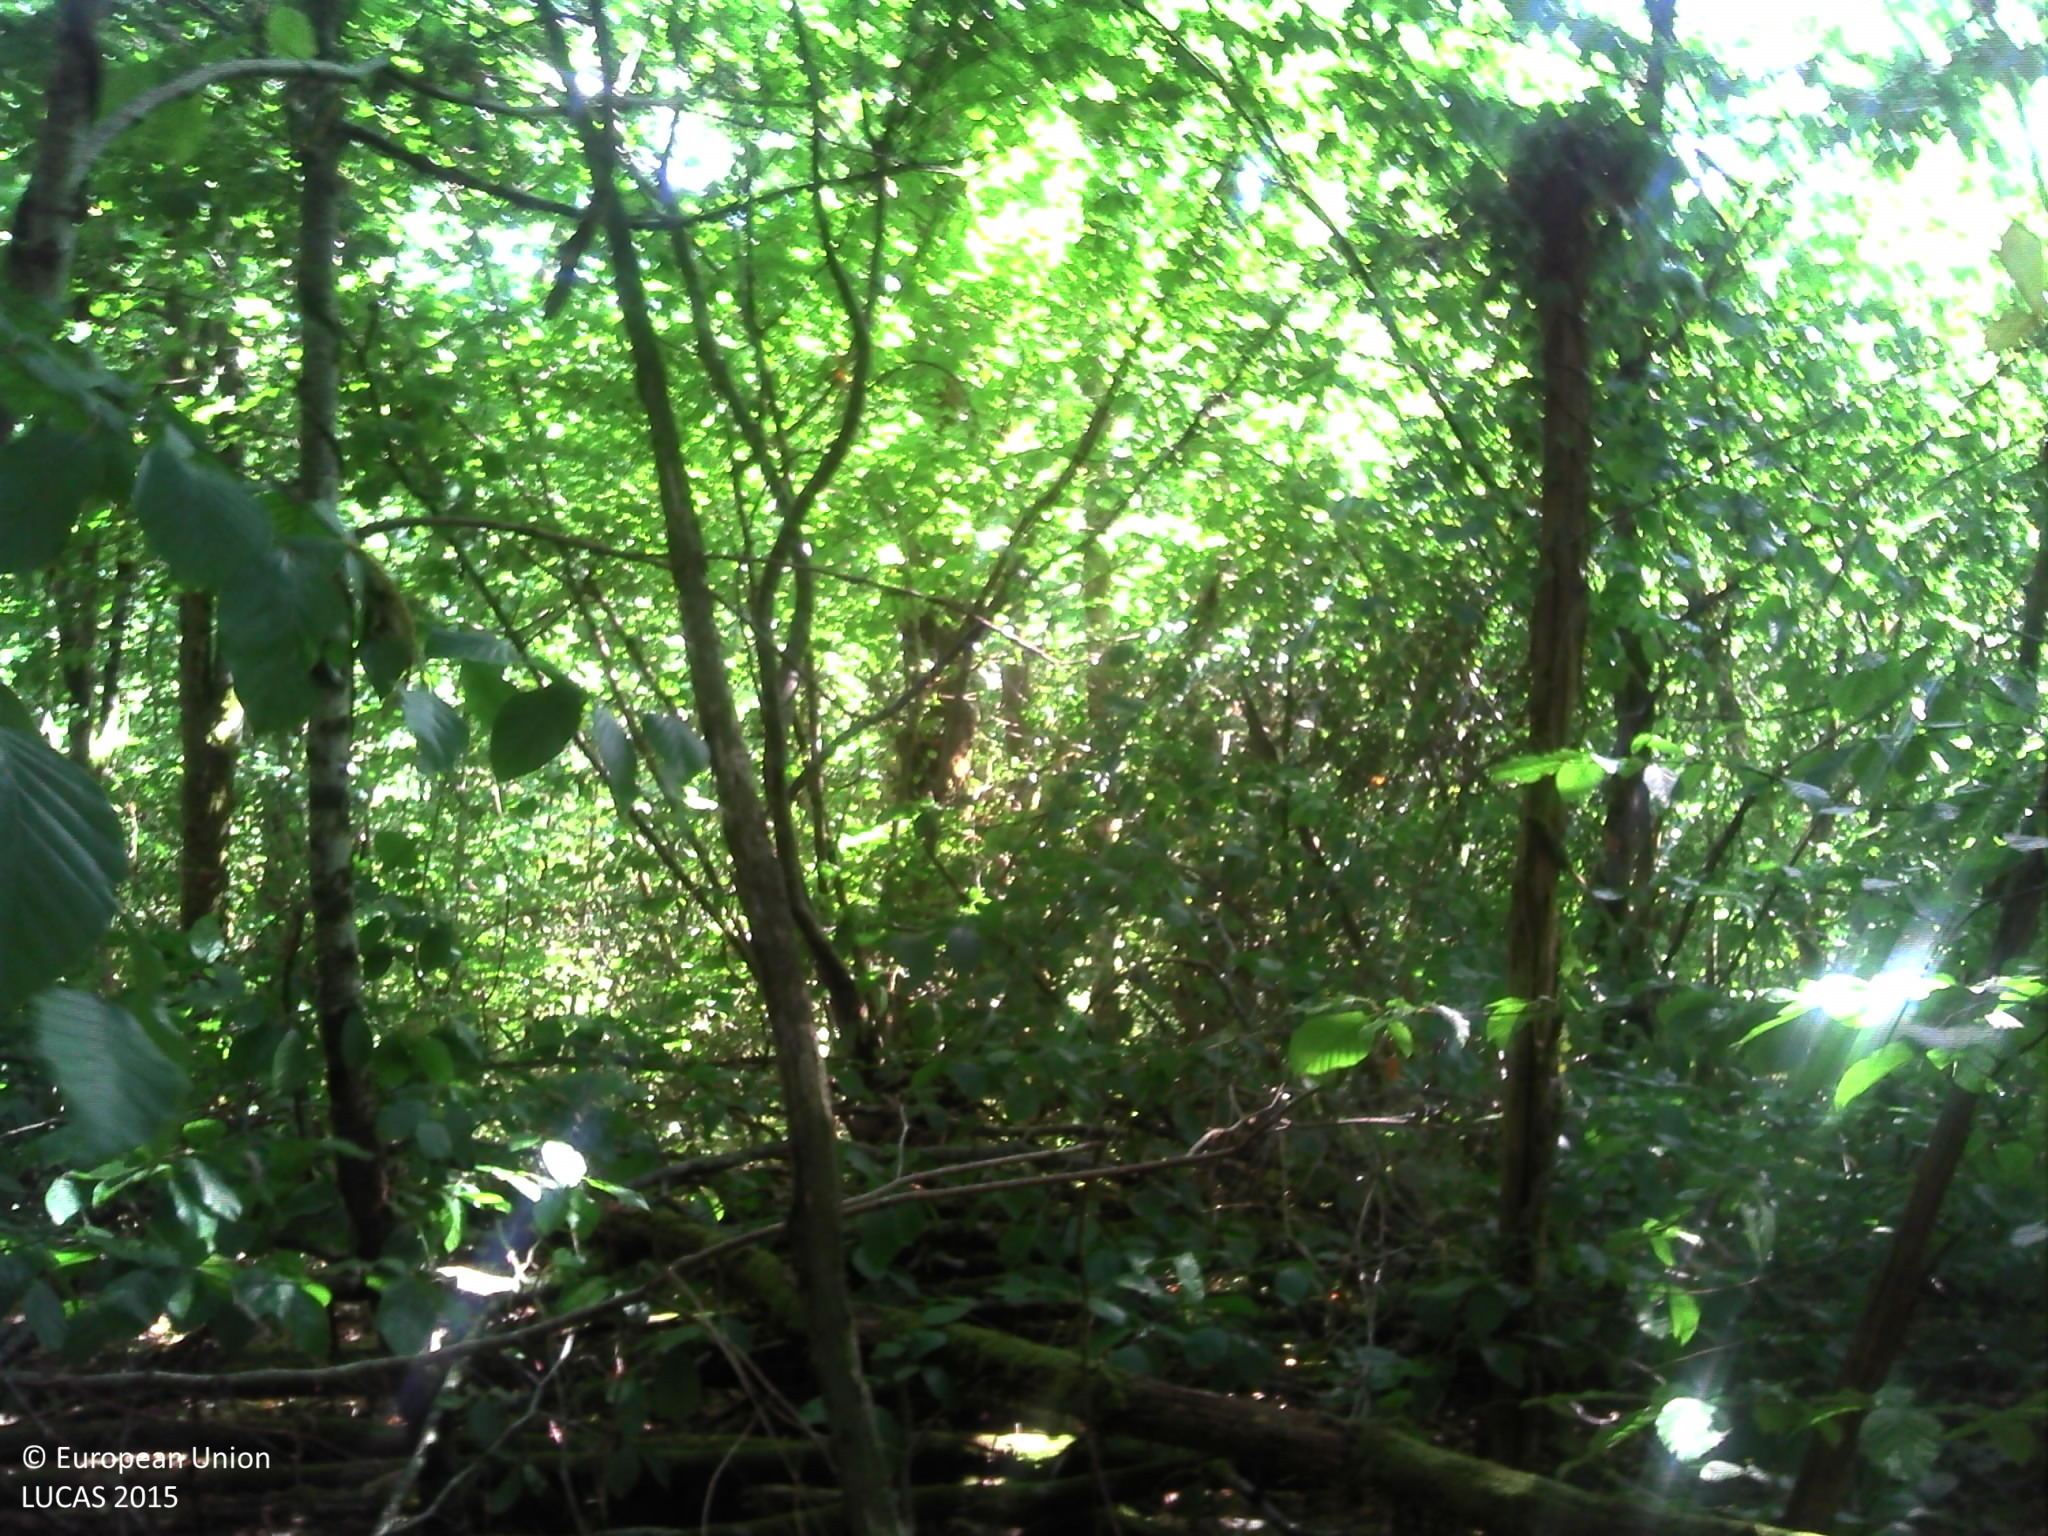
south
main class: Woodland
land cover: Broadleaved woodland
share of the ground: > 75 %
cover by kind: broadleaved forest trees 100 %
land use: Forestry
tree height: > 5 m
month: July
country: FR
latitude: 45.9906
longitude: 1.0159
